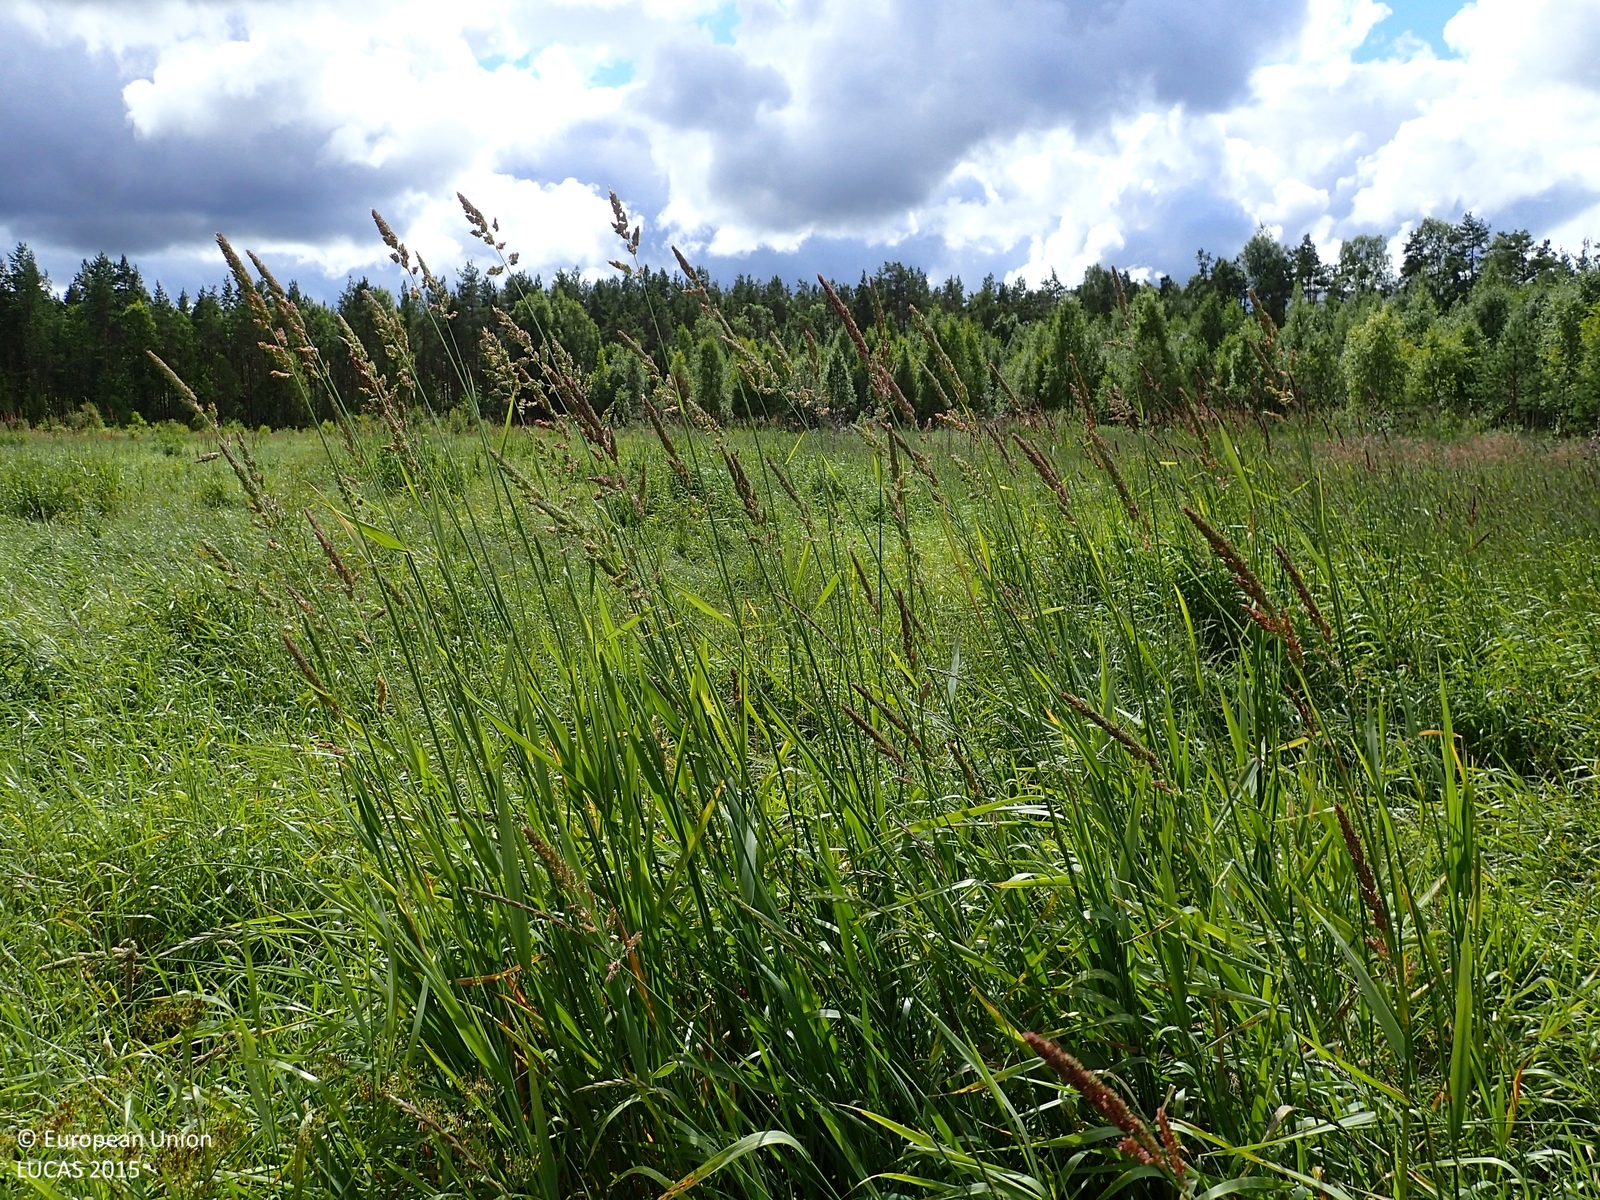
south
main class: Grassland
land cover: Spontaneously vegetated surfaces
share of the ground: > 75 %
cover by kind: herbaceous plants 100 %
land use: Fallow land
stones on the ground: < 10 %
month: August
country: FI
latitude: 62.6484
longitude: 21.6915
